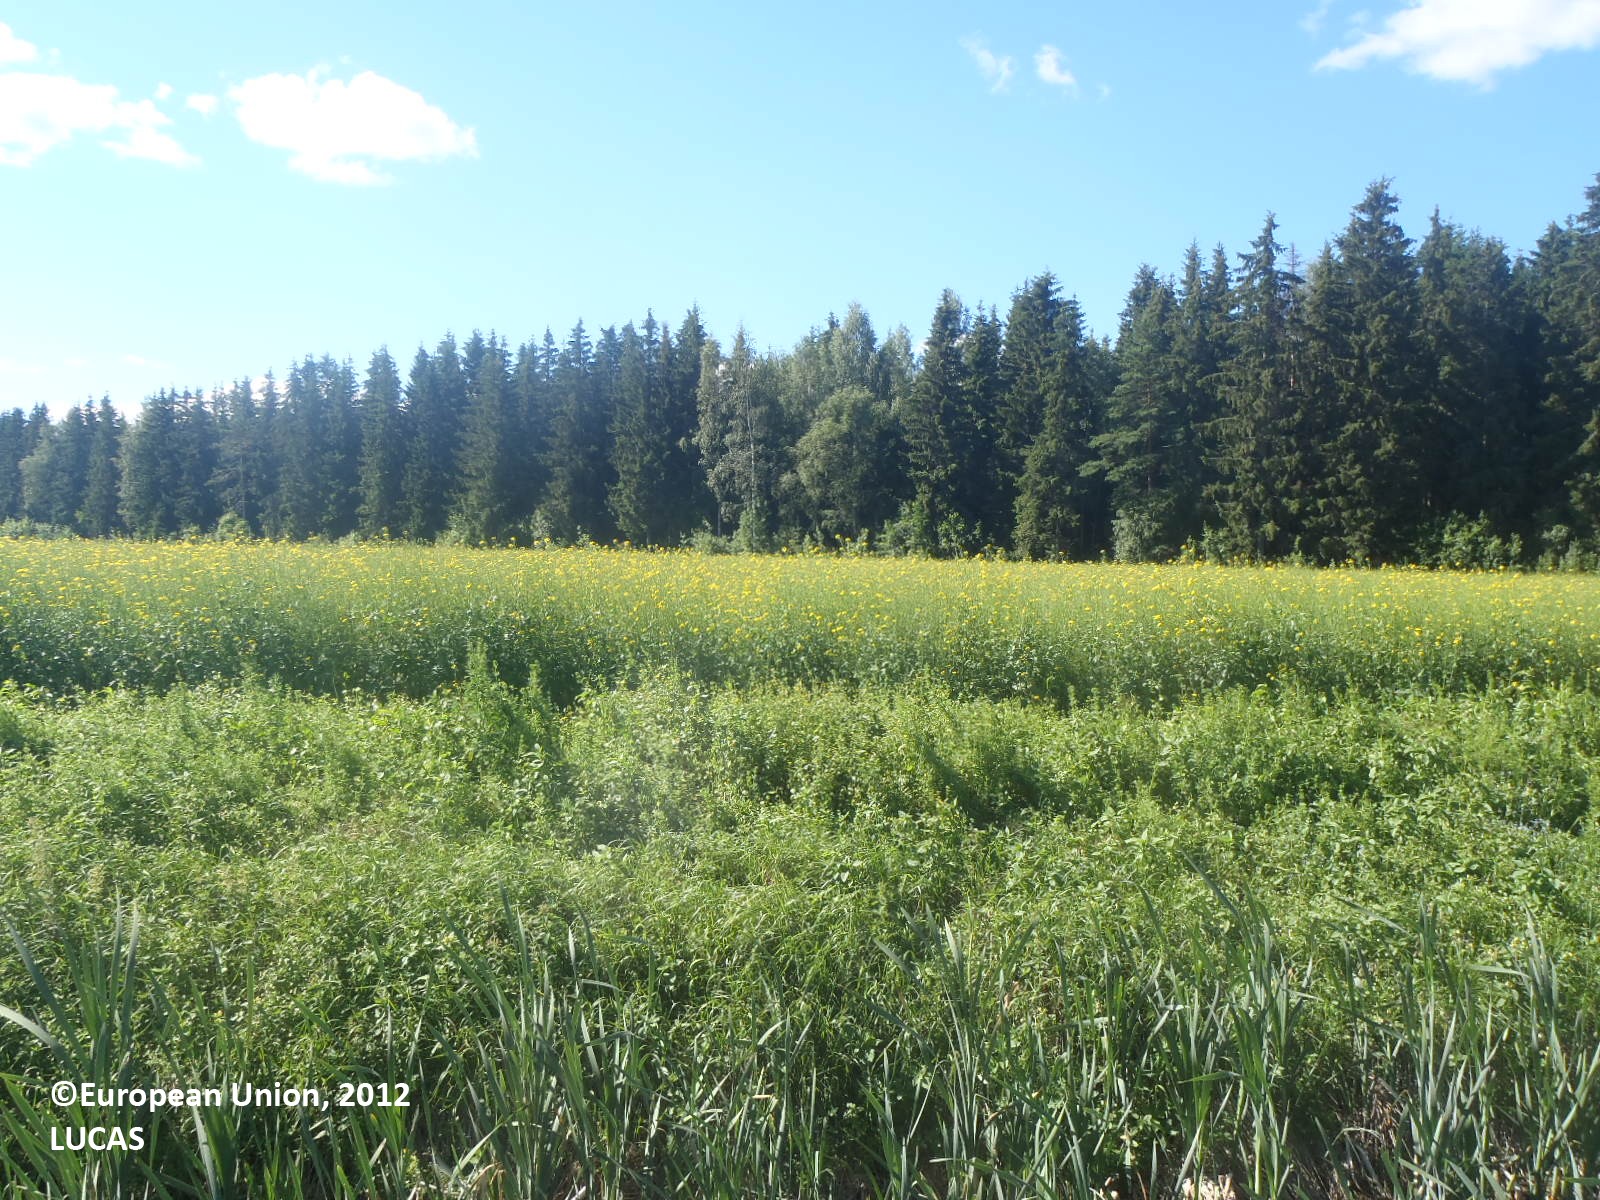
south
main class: Cropland
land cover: Oats
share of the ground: > 75 %
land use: Agriculture (excluding fallow land and kitchen gardens)
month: July
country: FI
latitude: 61.0438
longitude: 21.8902
